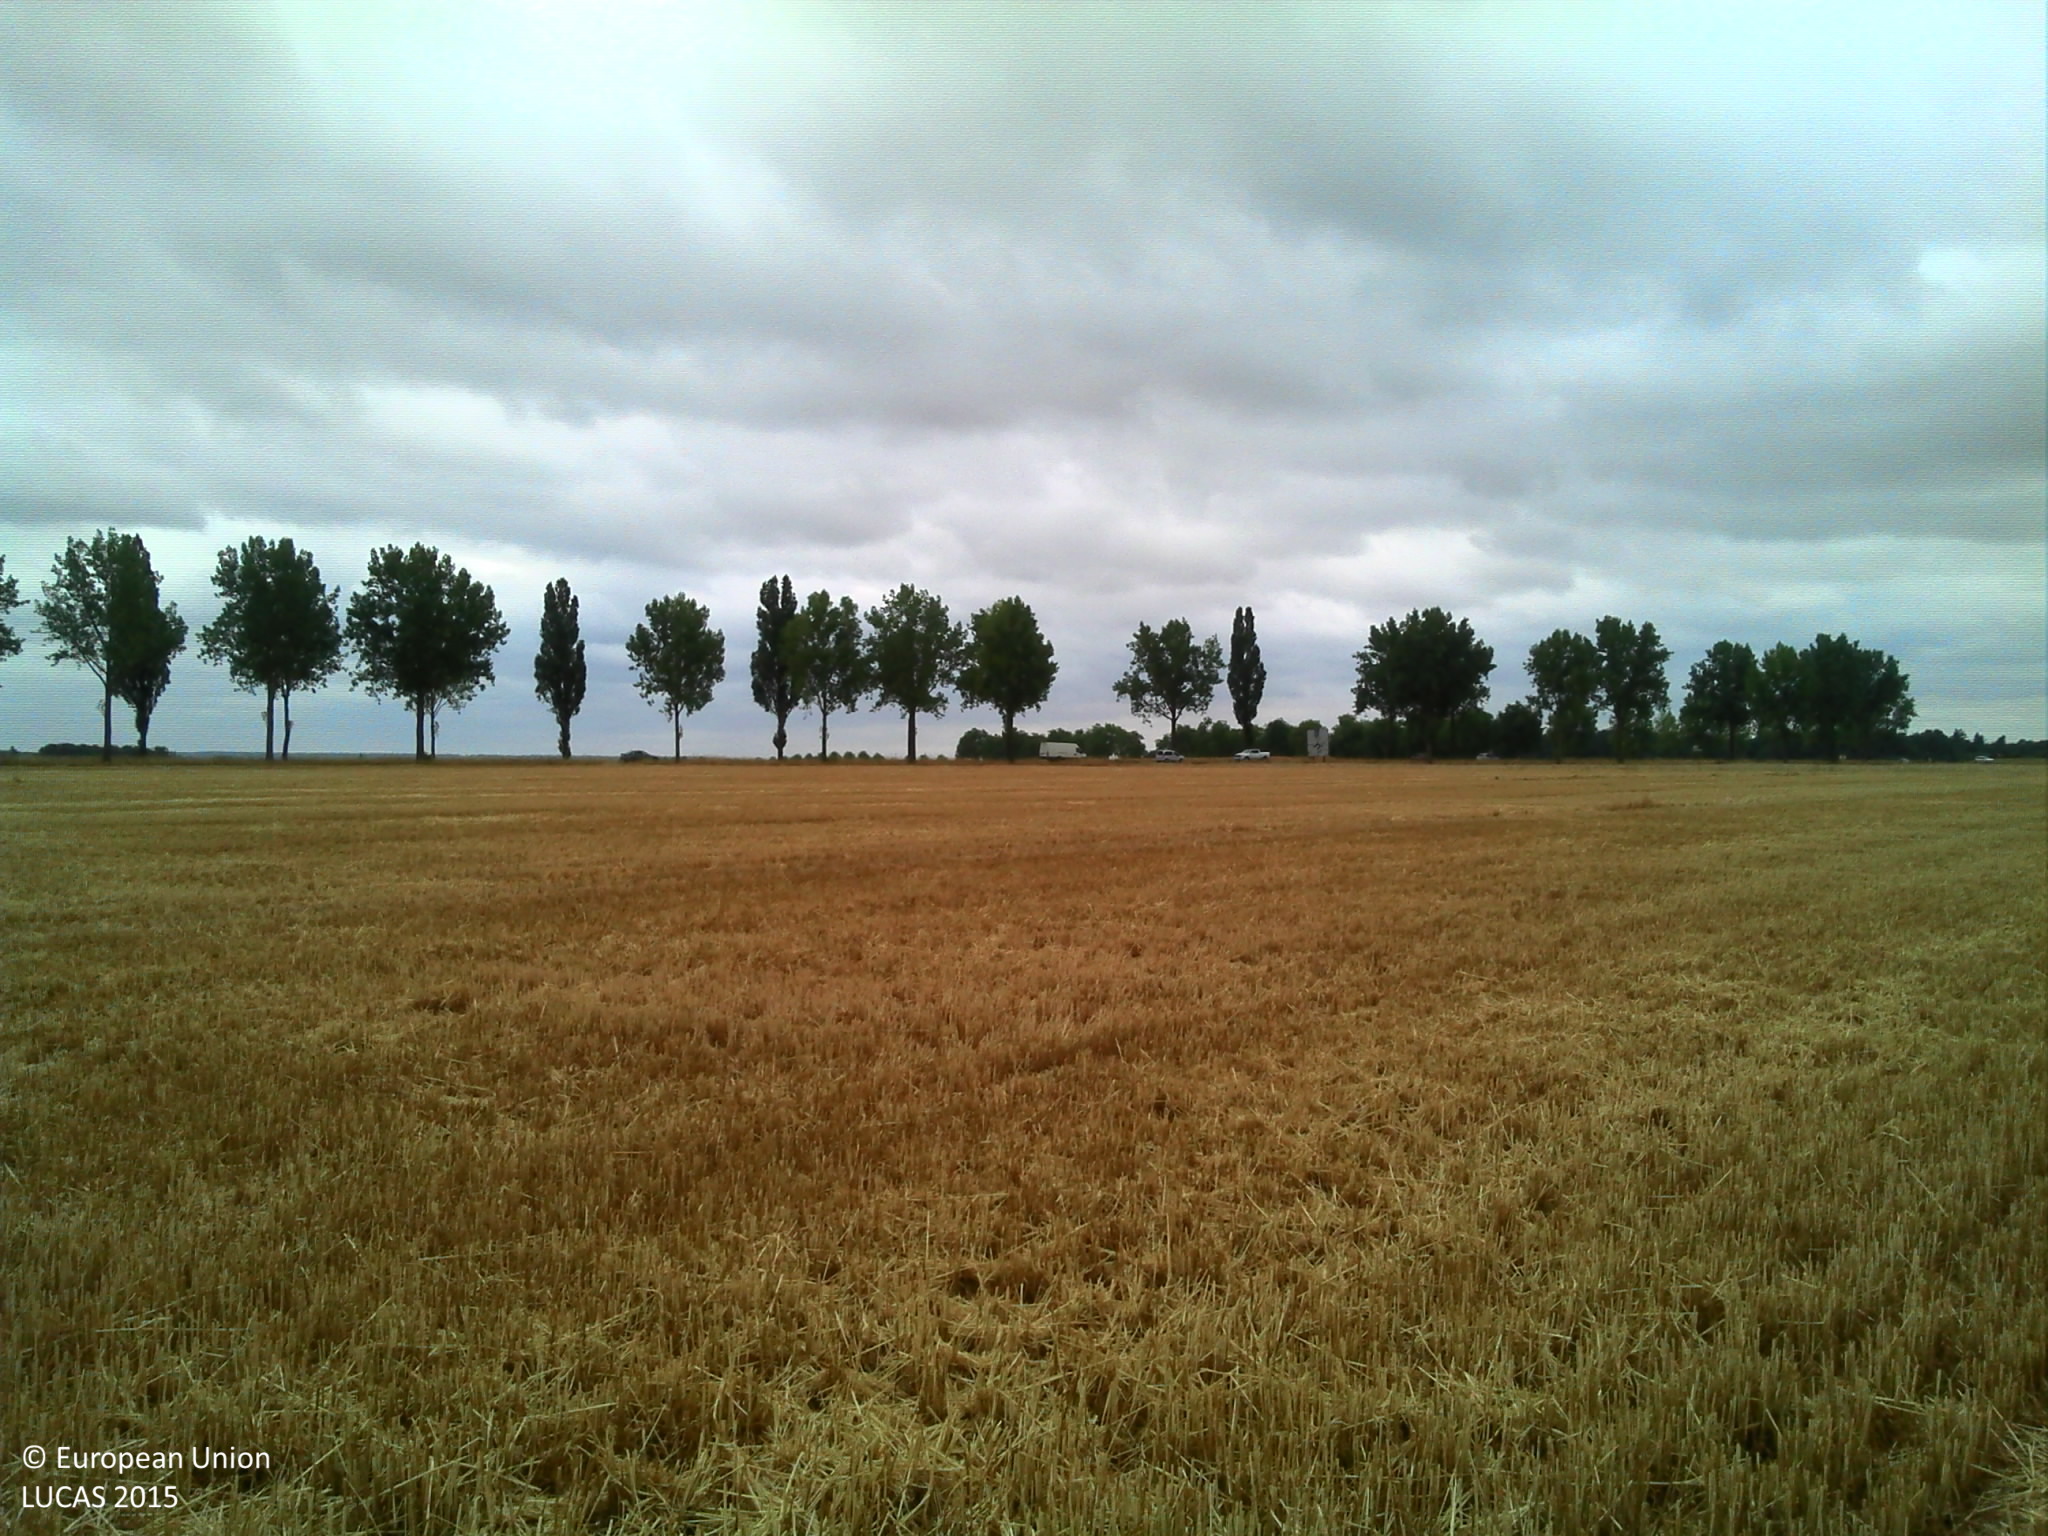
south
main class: Cropland
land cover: Common wheat
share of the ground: > 75 %
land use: Agriculture (excluding fallow land and kitchen gardens)
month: July
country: FR
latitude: 48.4978
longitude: 2.5872
